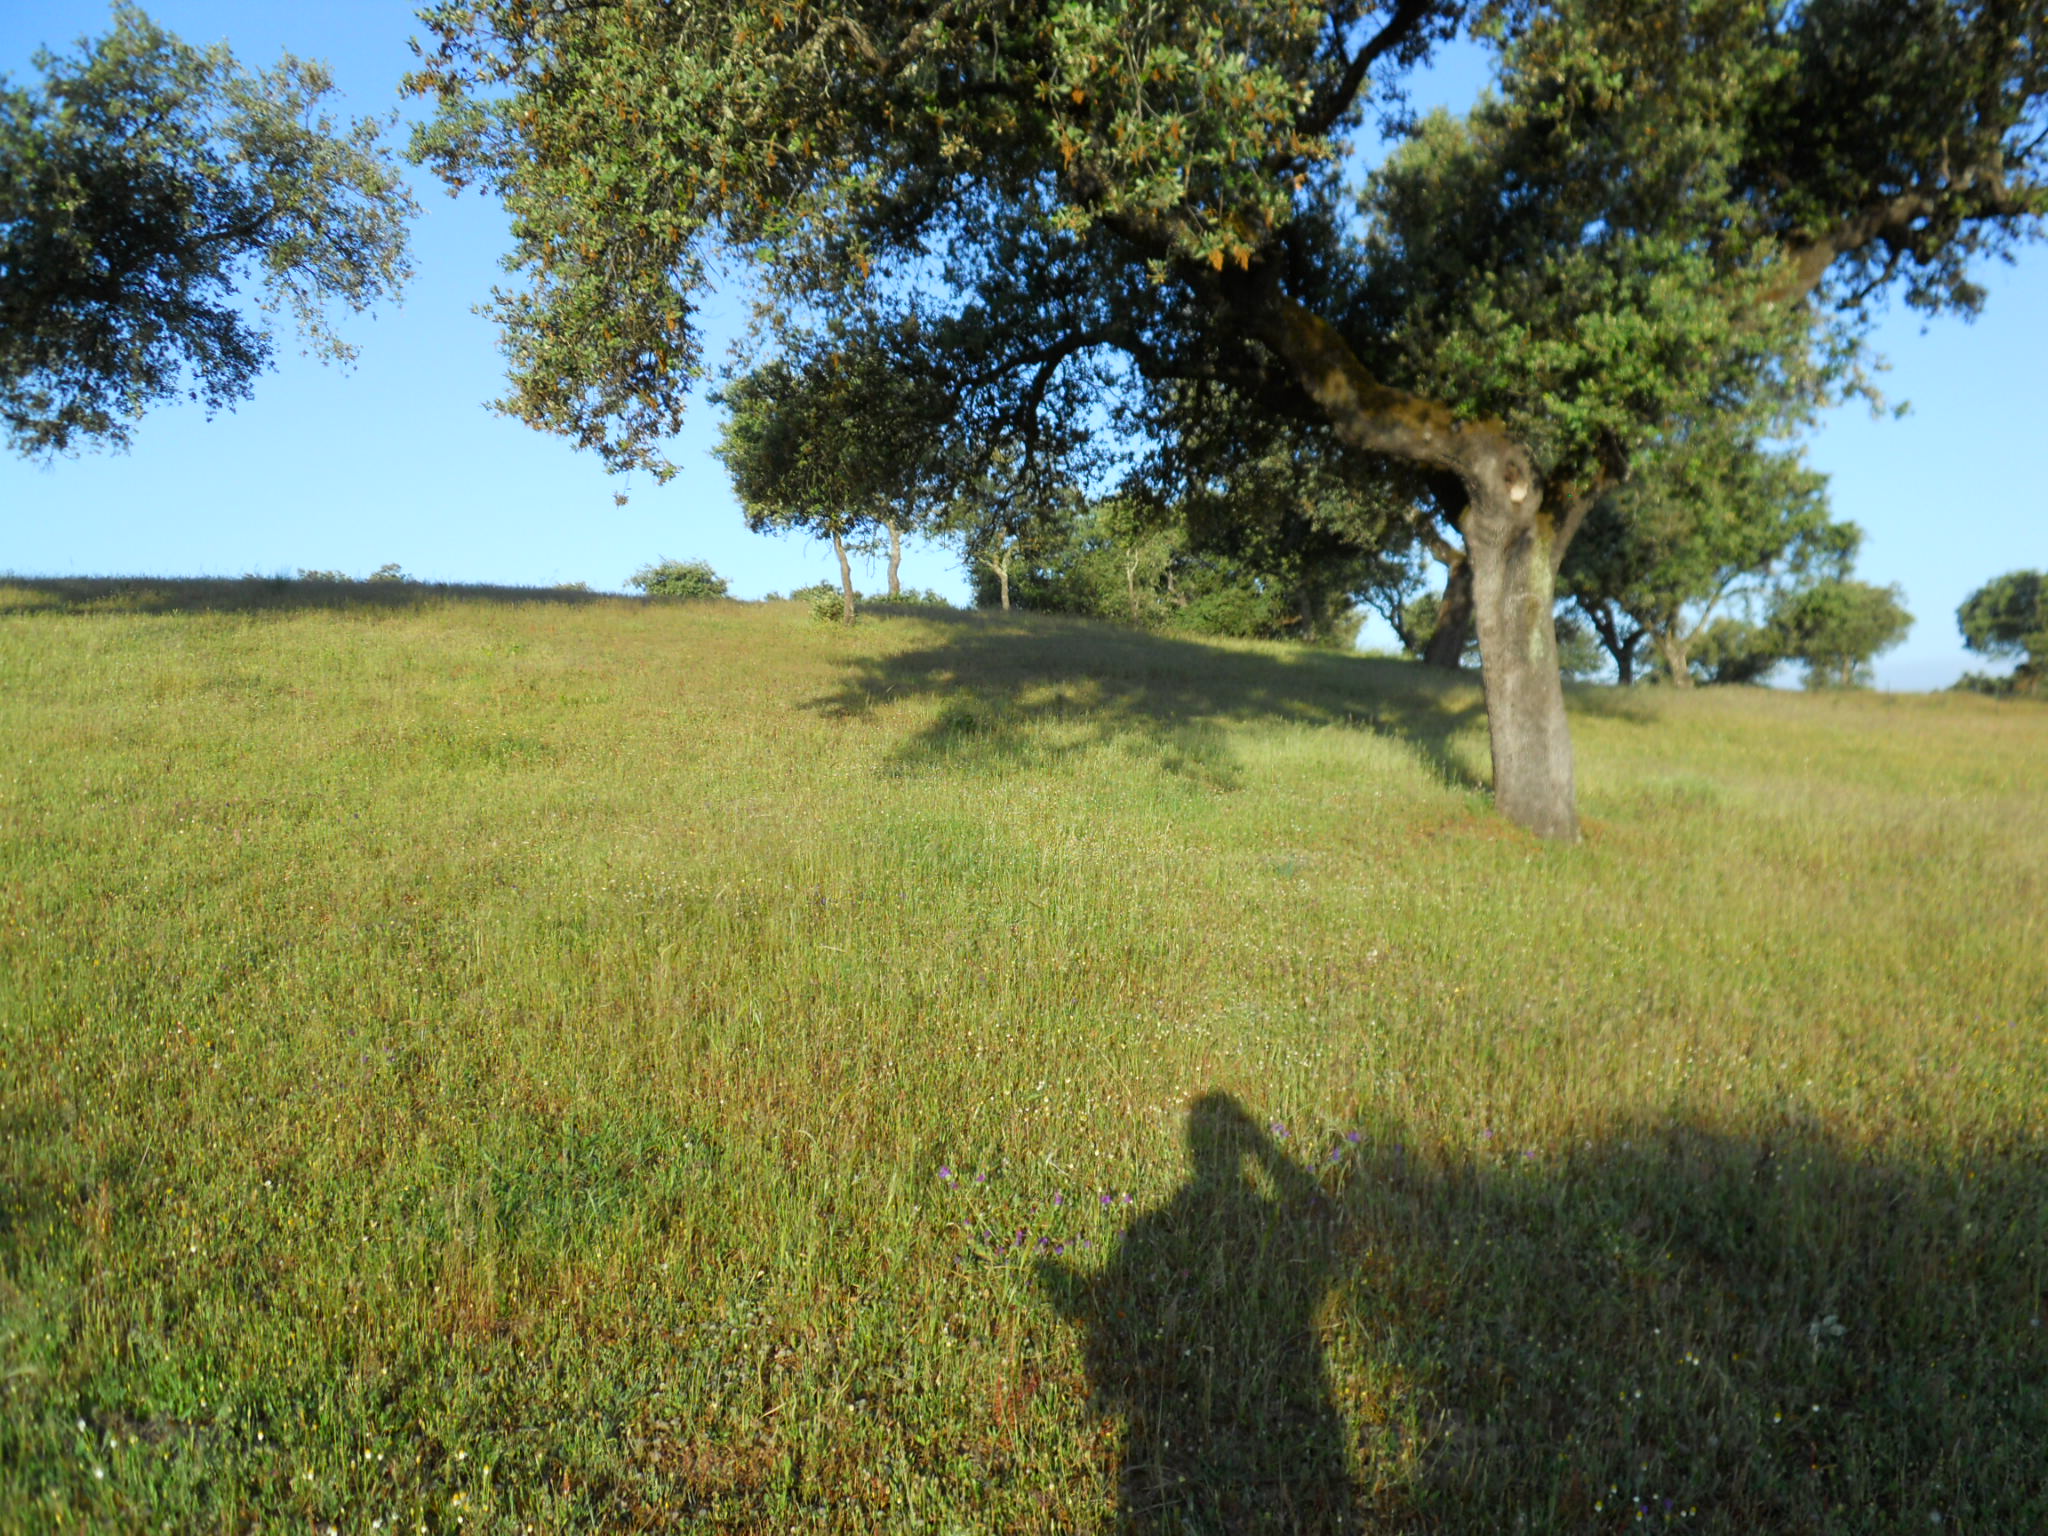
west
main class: Woodland
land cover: Broadleaved woodland
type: broadleaved evergreen forest
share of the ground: 25 - 50 %
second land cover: Grassland without tree/shrub cover
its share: > 75 %
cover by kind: herbaceous plants 70 %, broadleaved forest trees 30 %
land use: Forestry
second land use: Agriculture (excluding fallow land and kitchen gardens)
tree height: > 5 m
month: May
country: ES
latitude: 39.1208
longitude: -6.9019
